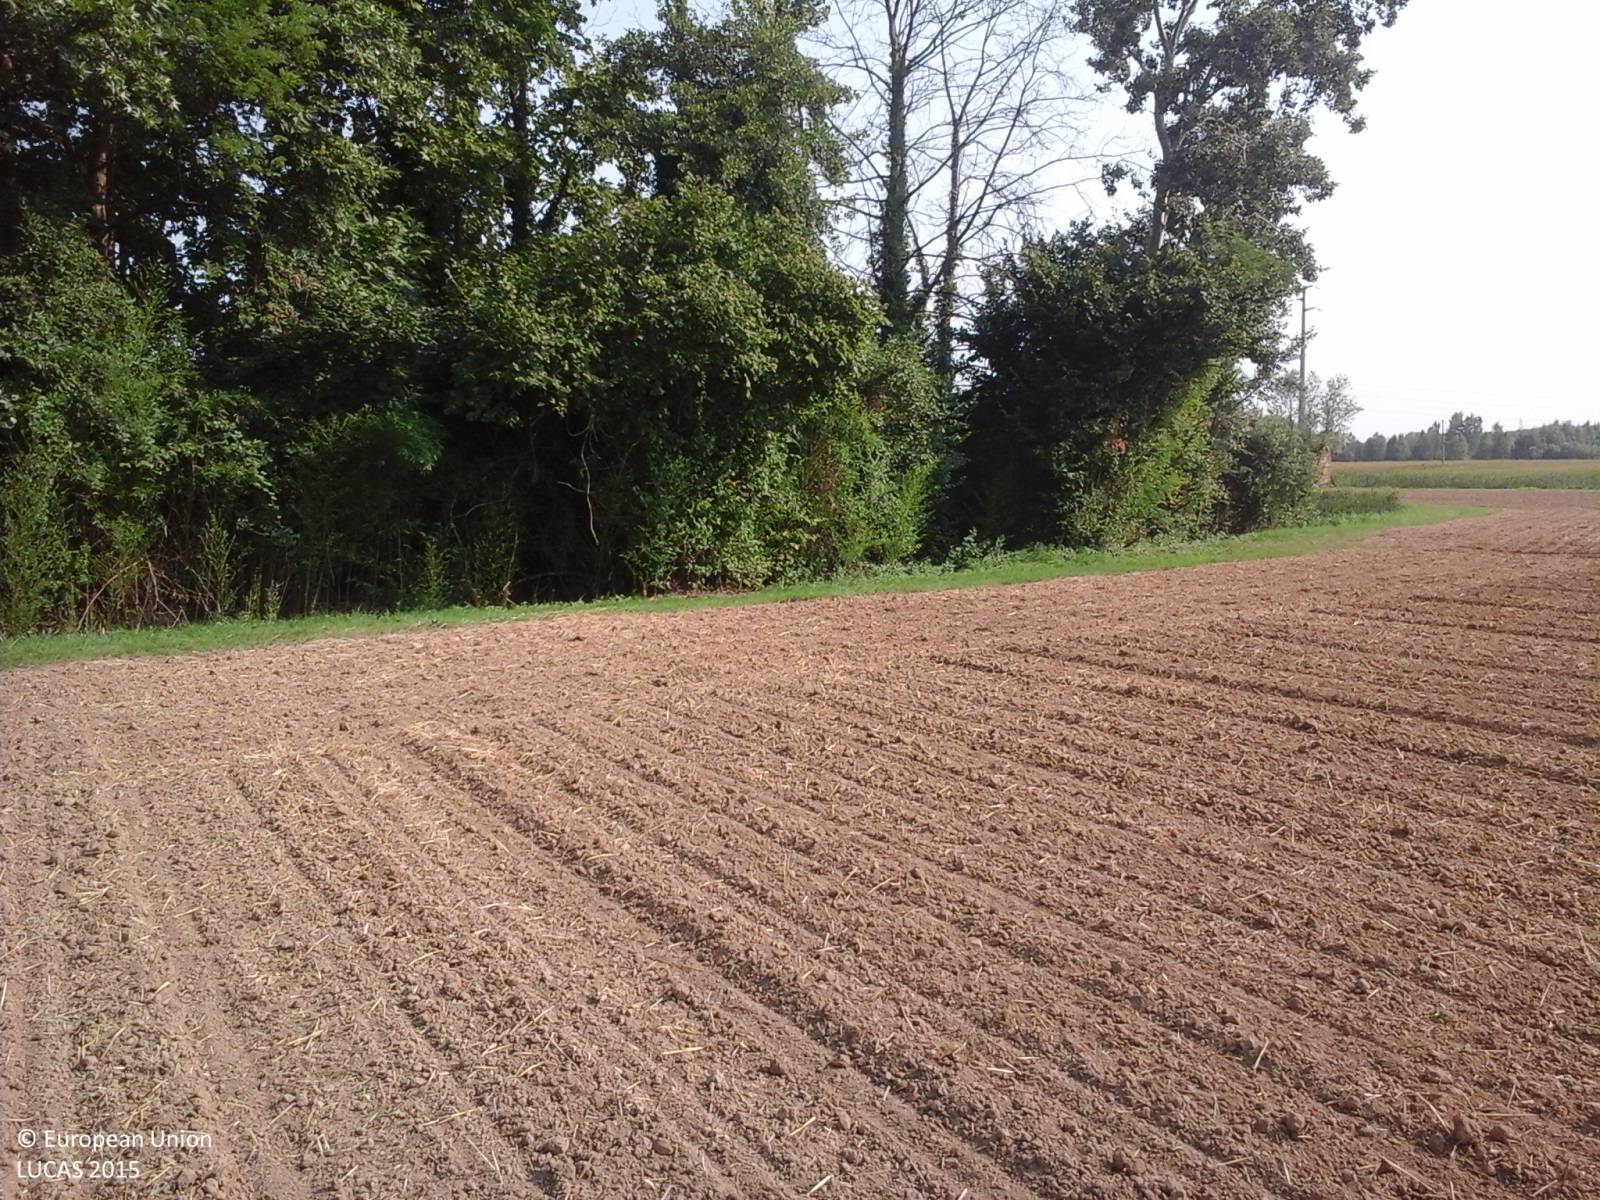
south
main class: Cropland
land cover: Common wheat
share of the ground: < 10 %
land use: Agriculture (excluding fallow land and kitchen gardens)
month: July
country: IT
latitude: 45.9208
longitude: 12.6914
